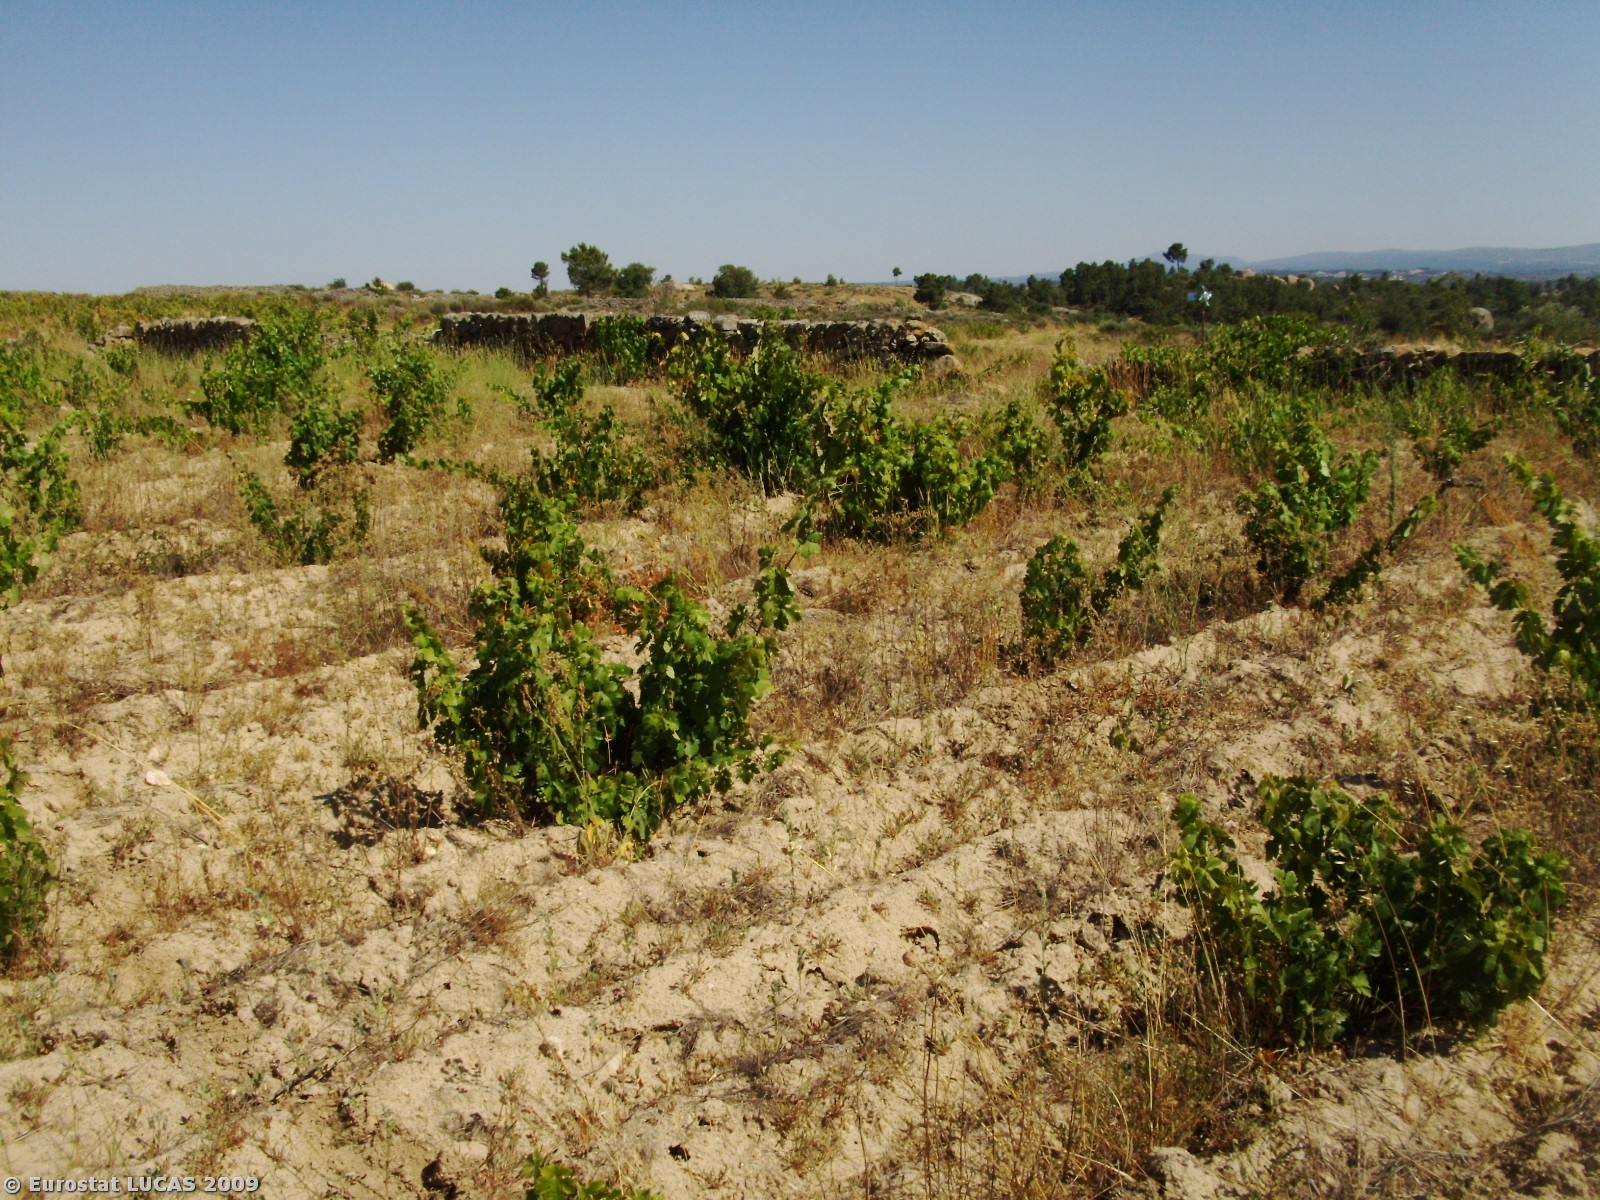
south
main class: Cropland
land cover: Vineyards
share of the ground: 50 - 75 %
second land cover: Bare land
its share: 25 - 50 %
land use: Agriculture (excluding fallow land and kitchen gardens)
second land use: Fallow land
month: July
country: PT
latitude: 40.5029
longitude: -7.0089
